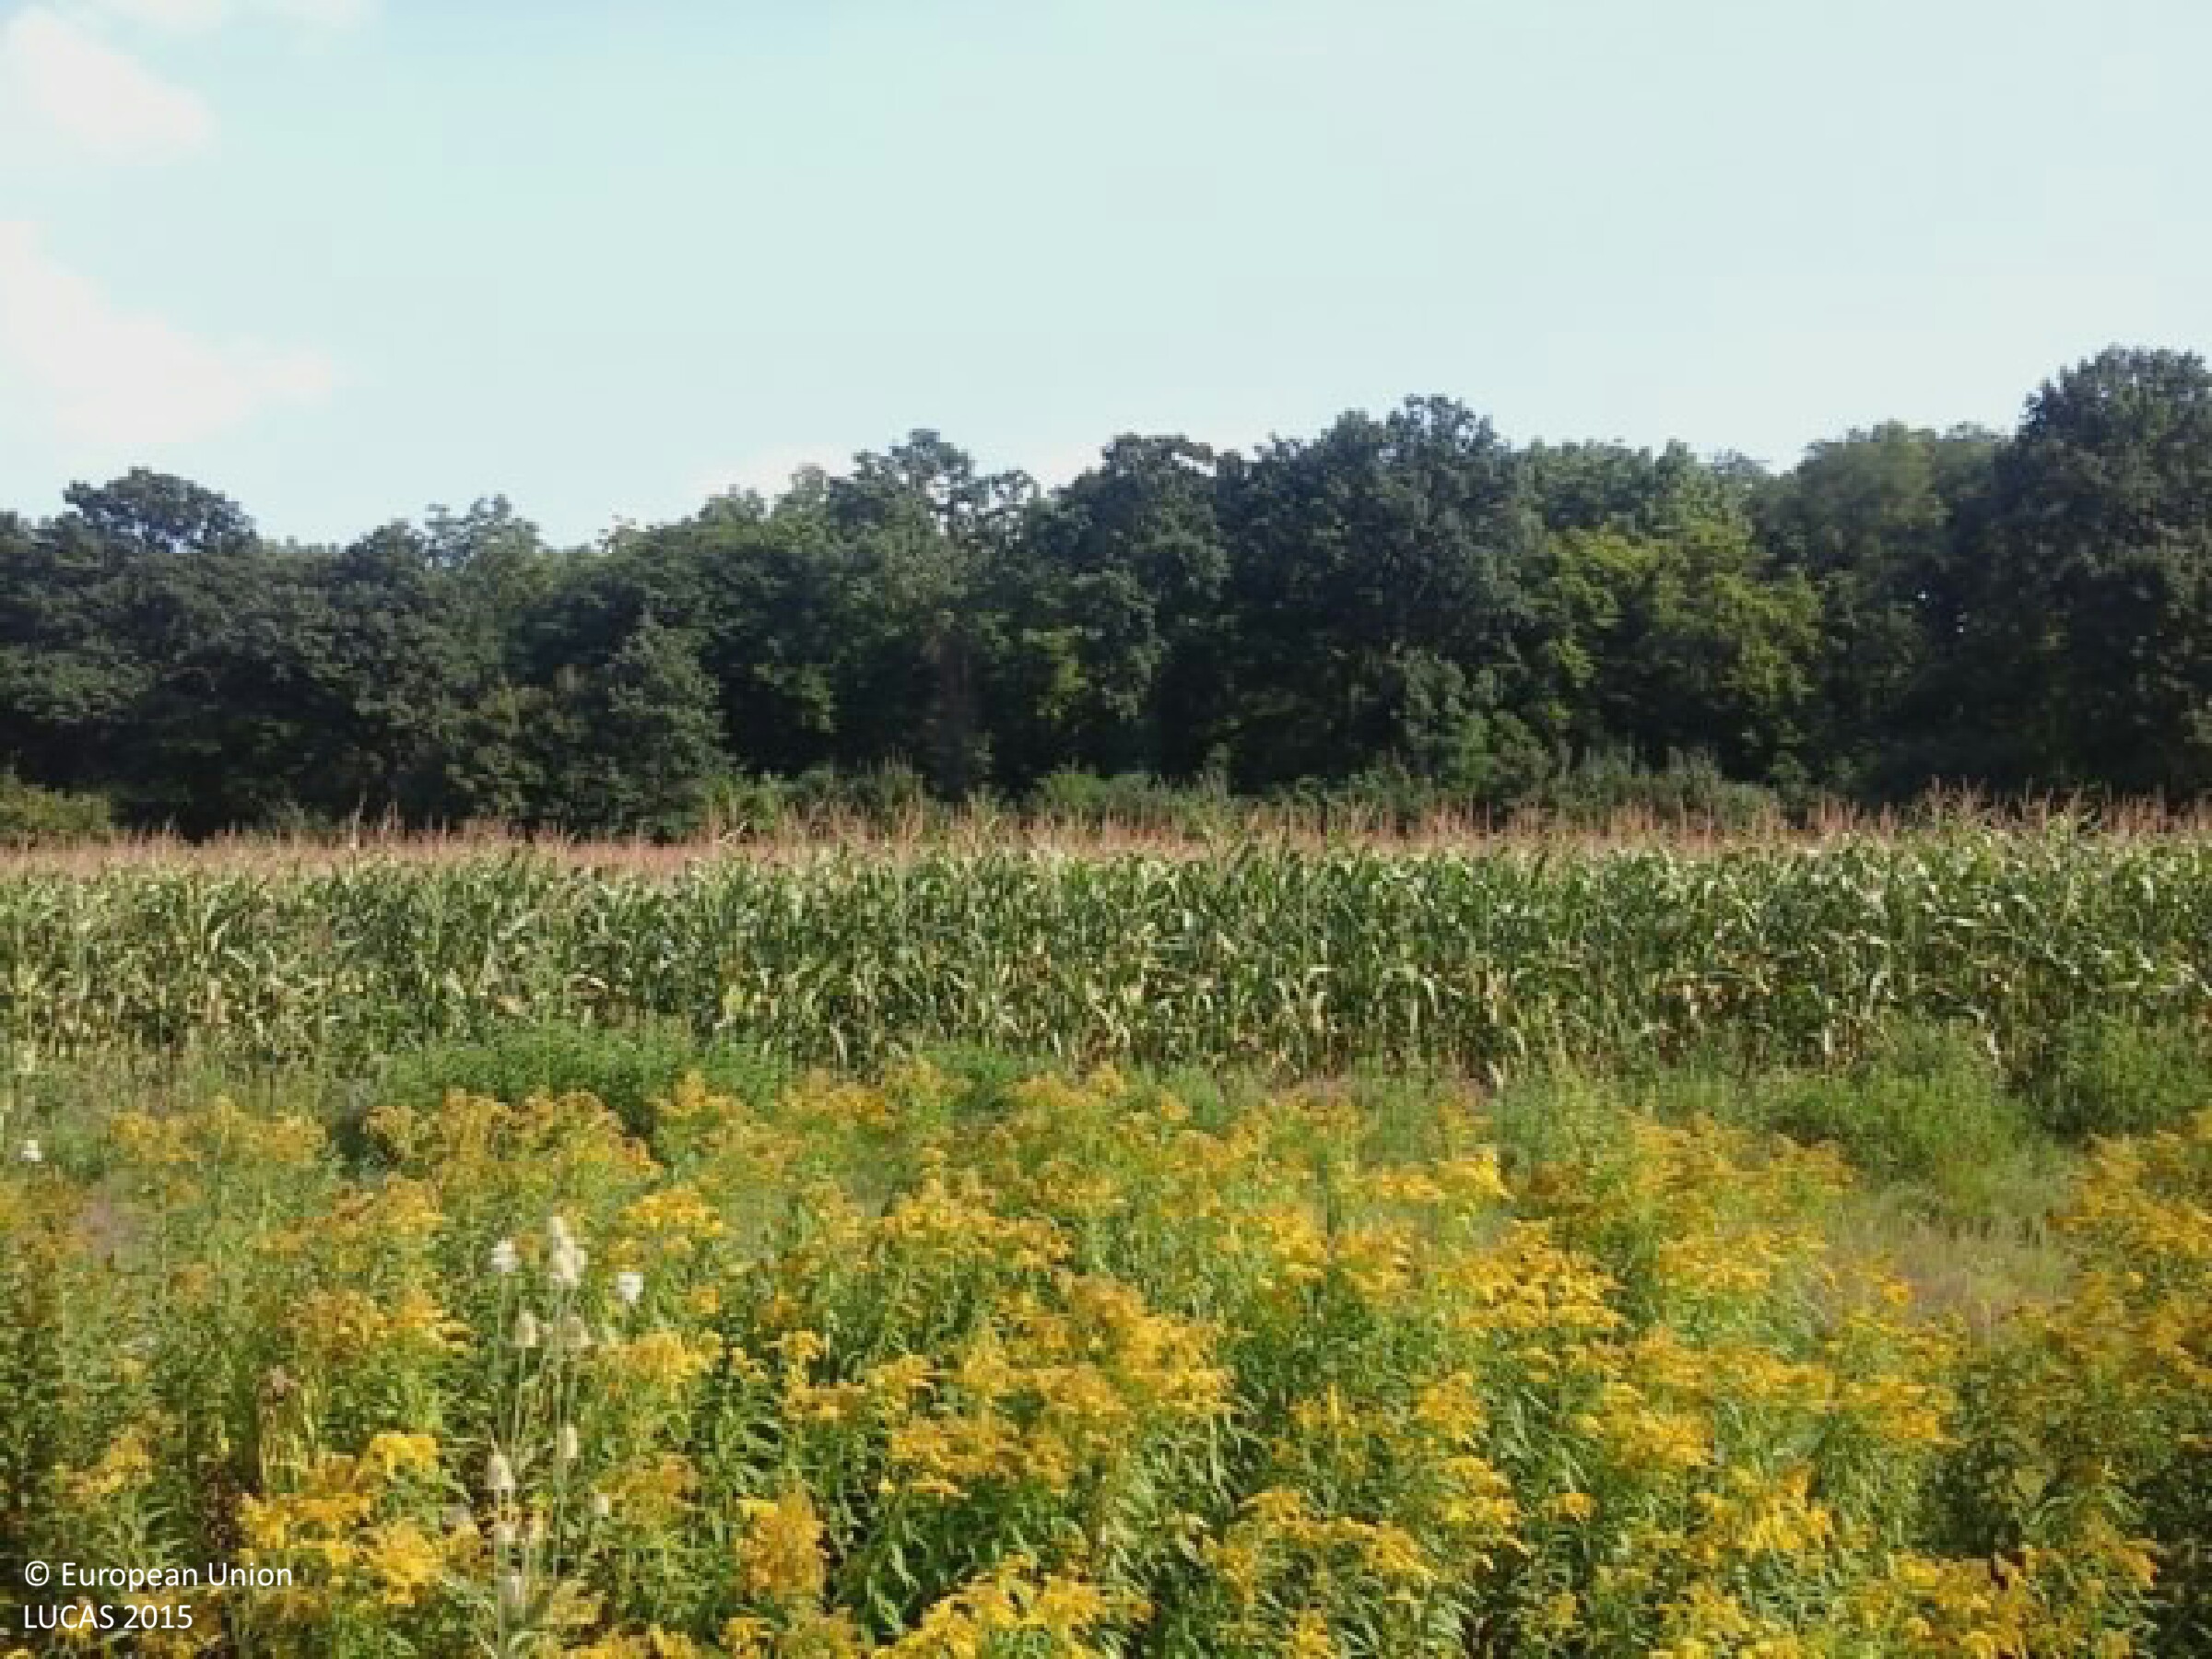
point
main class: Woodland
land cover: Broadleaved woodland
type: mesophytic deciduous forest
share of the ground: > 75 %
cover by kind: broadleaved forest trees 95 %, herbaceous plants 5 %
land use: Forestry
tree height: < 5 m
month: August
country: HU
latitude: 46.4843
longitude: 18.2545
